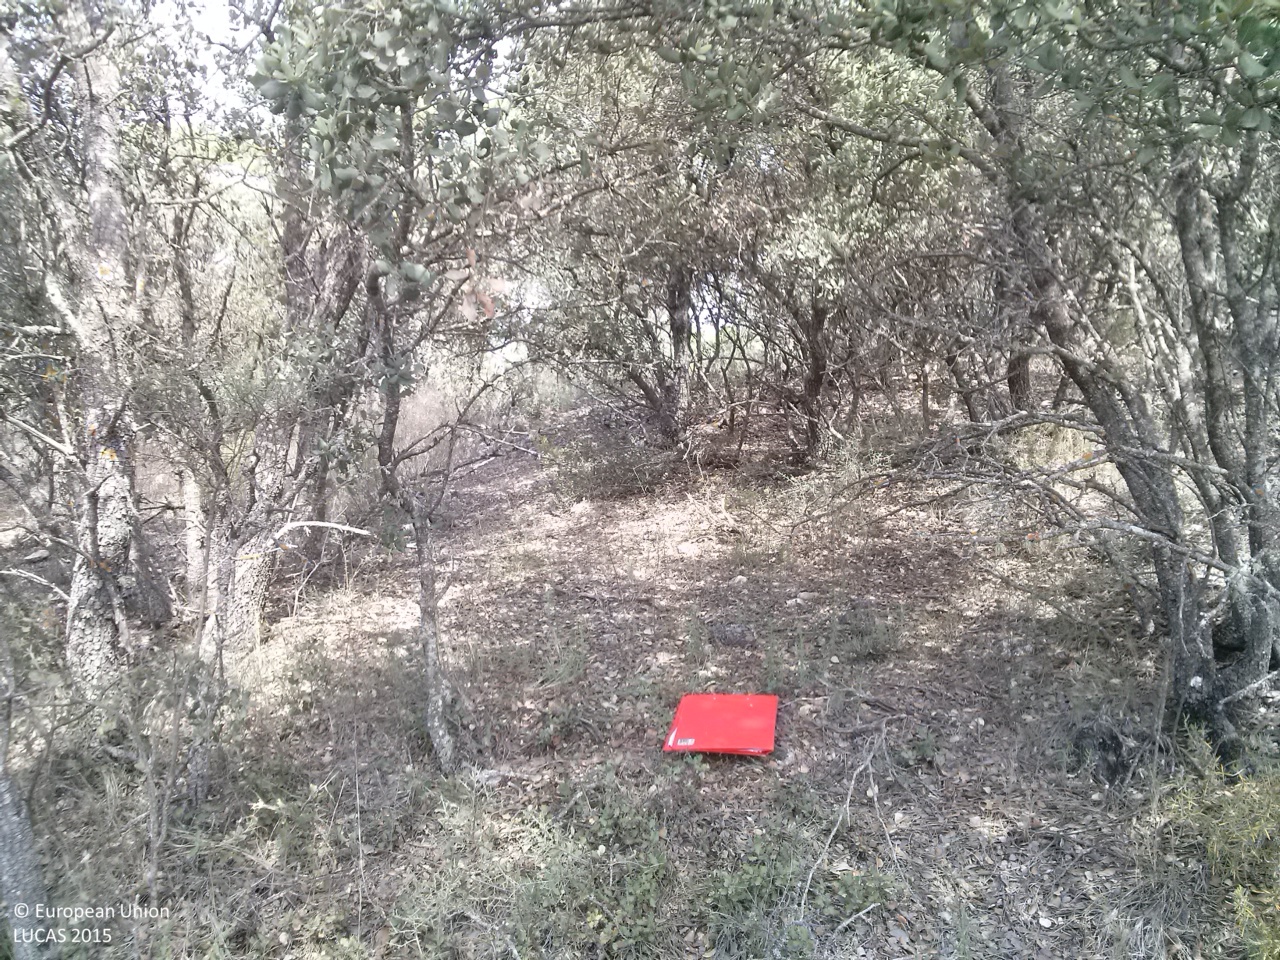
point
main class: Woodland
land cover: Other mixed woodland
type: broadleaved evergreen forest
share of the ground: 50 - 75 %
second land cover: Shrubland without tree cover
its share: 10 - 25 %
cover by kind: broadleaved forest trees 45 %, coniferous forest trees 25 %, shrubs 20 %, herbaceous plants 10 %
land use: Forestry
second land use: Agriculture (excluding fallow land and kitchen gardens)
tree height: > 5 m
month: June
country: ES
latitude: 39.9668
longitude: -1.8485
